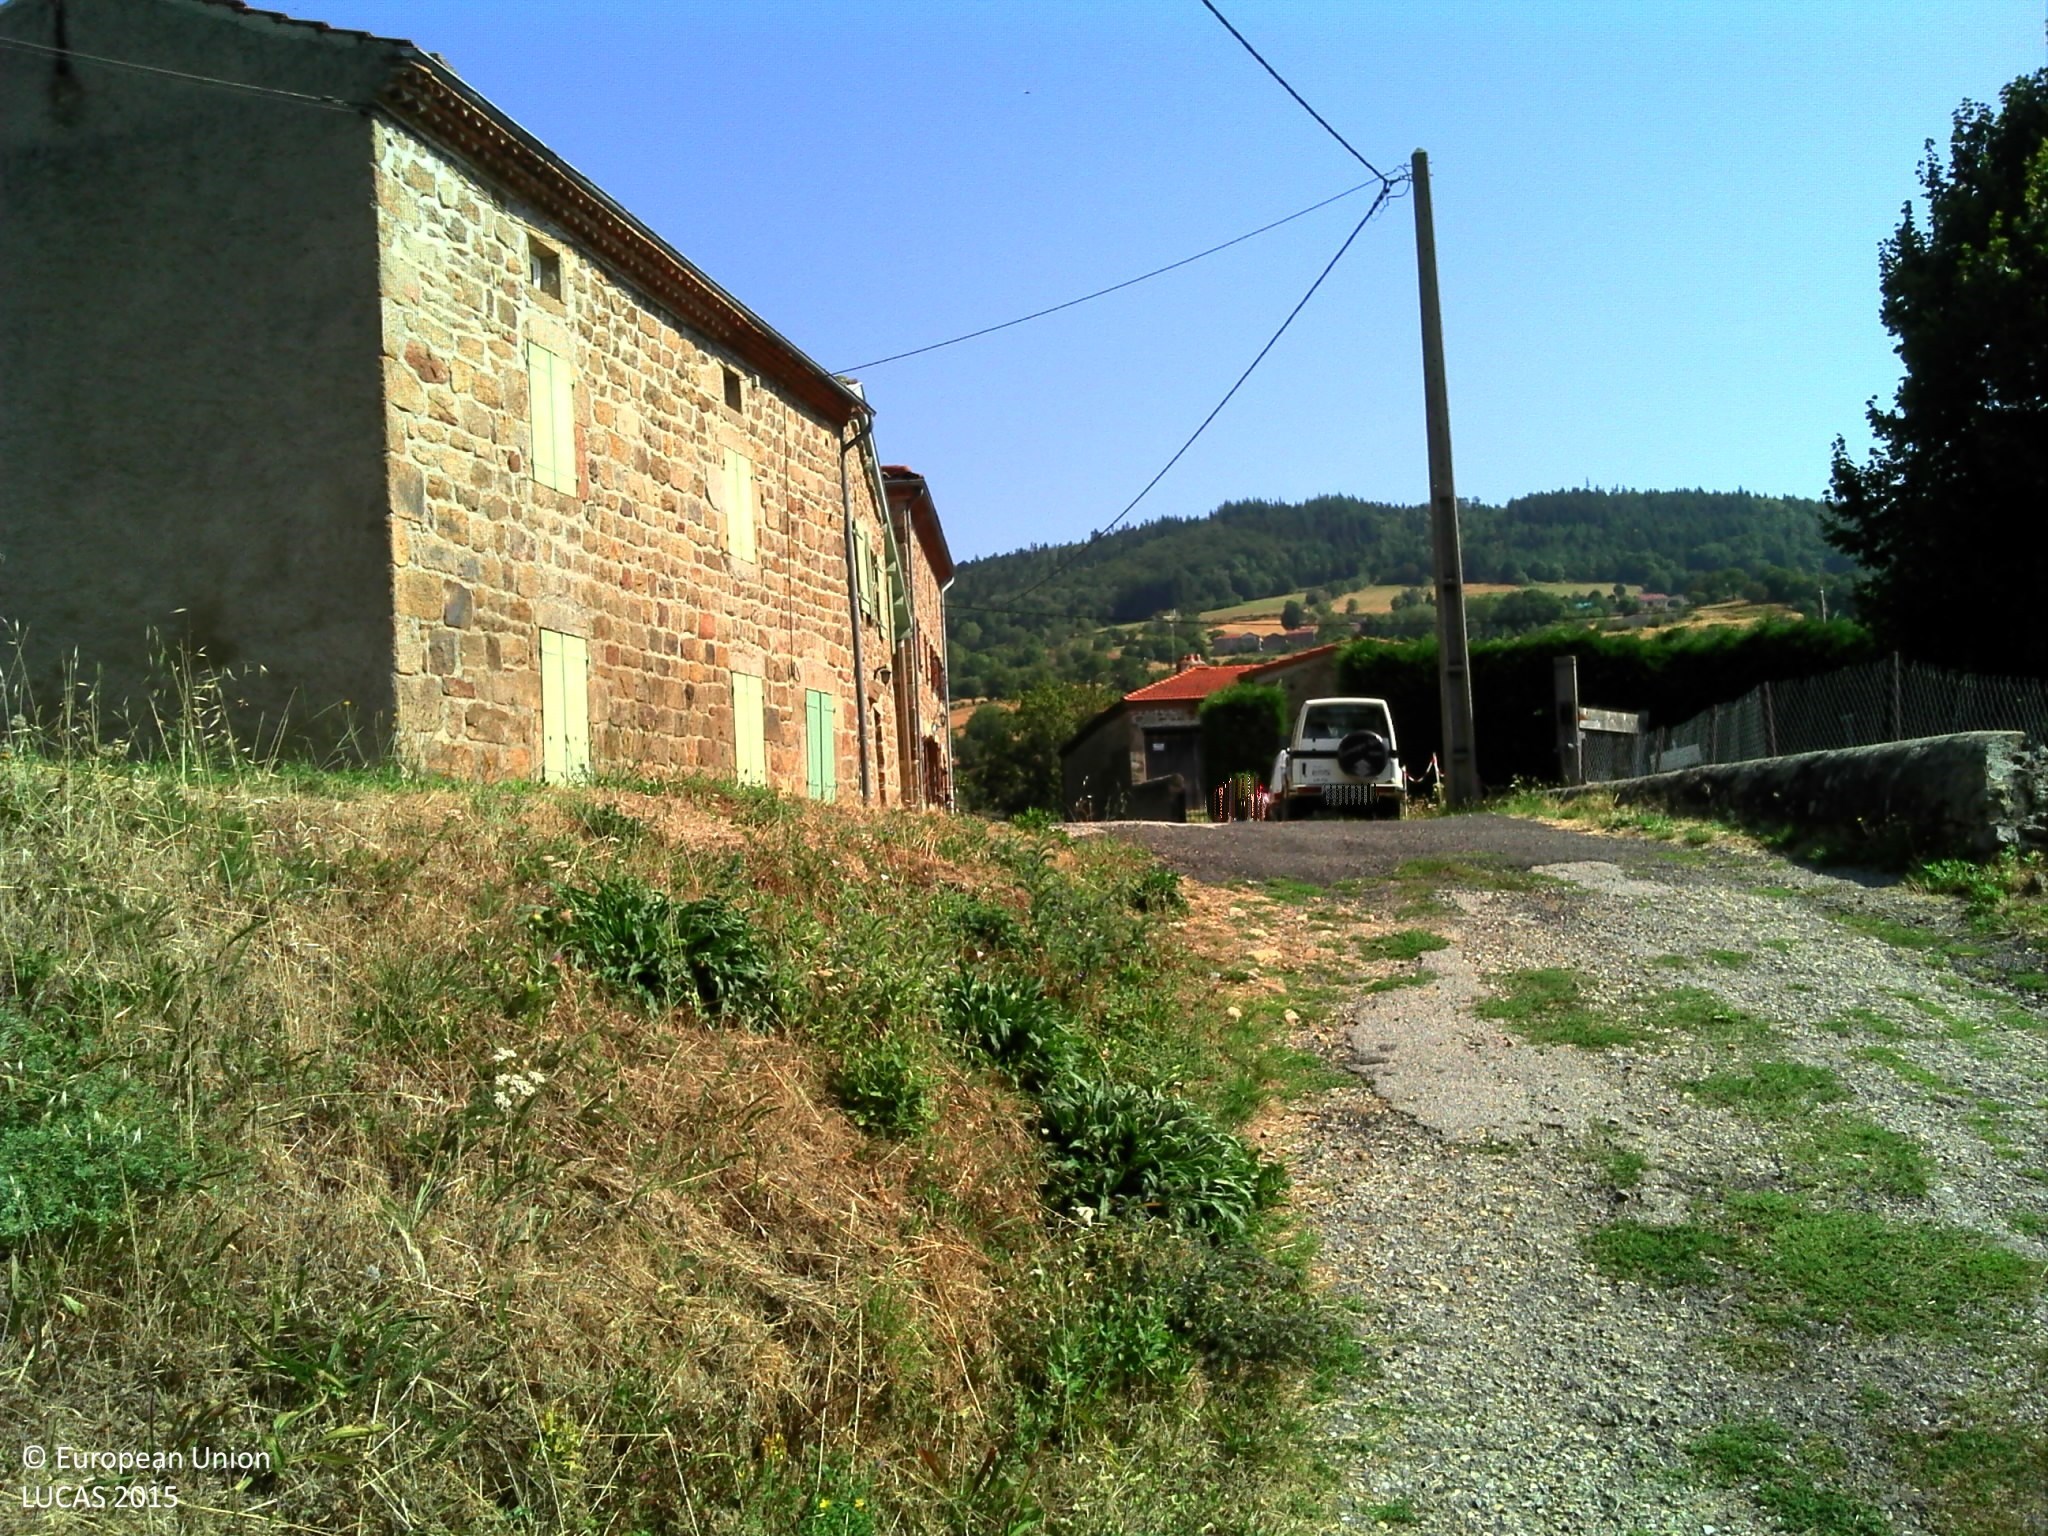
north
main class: Grassland
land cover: Grassland without tree/shrub cover
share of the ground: > 75 %
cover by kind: herbaceous plants 95 %, unconsolidated bare surface 5 %
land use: Semi-natural and natural areas not in use
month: August
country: FR
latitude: 45.3484
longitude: 4.6054
